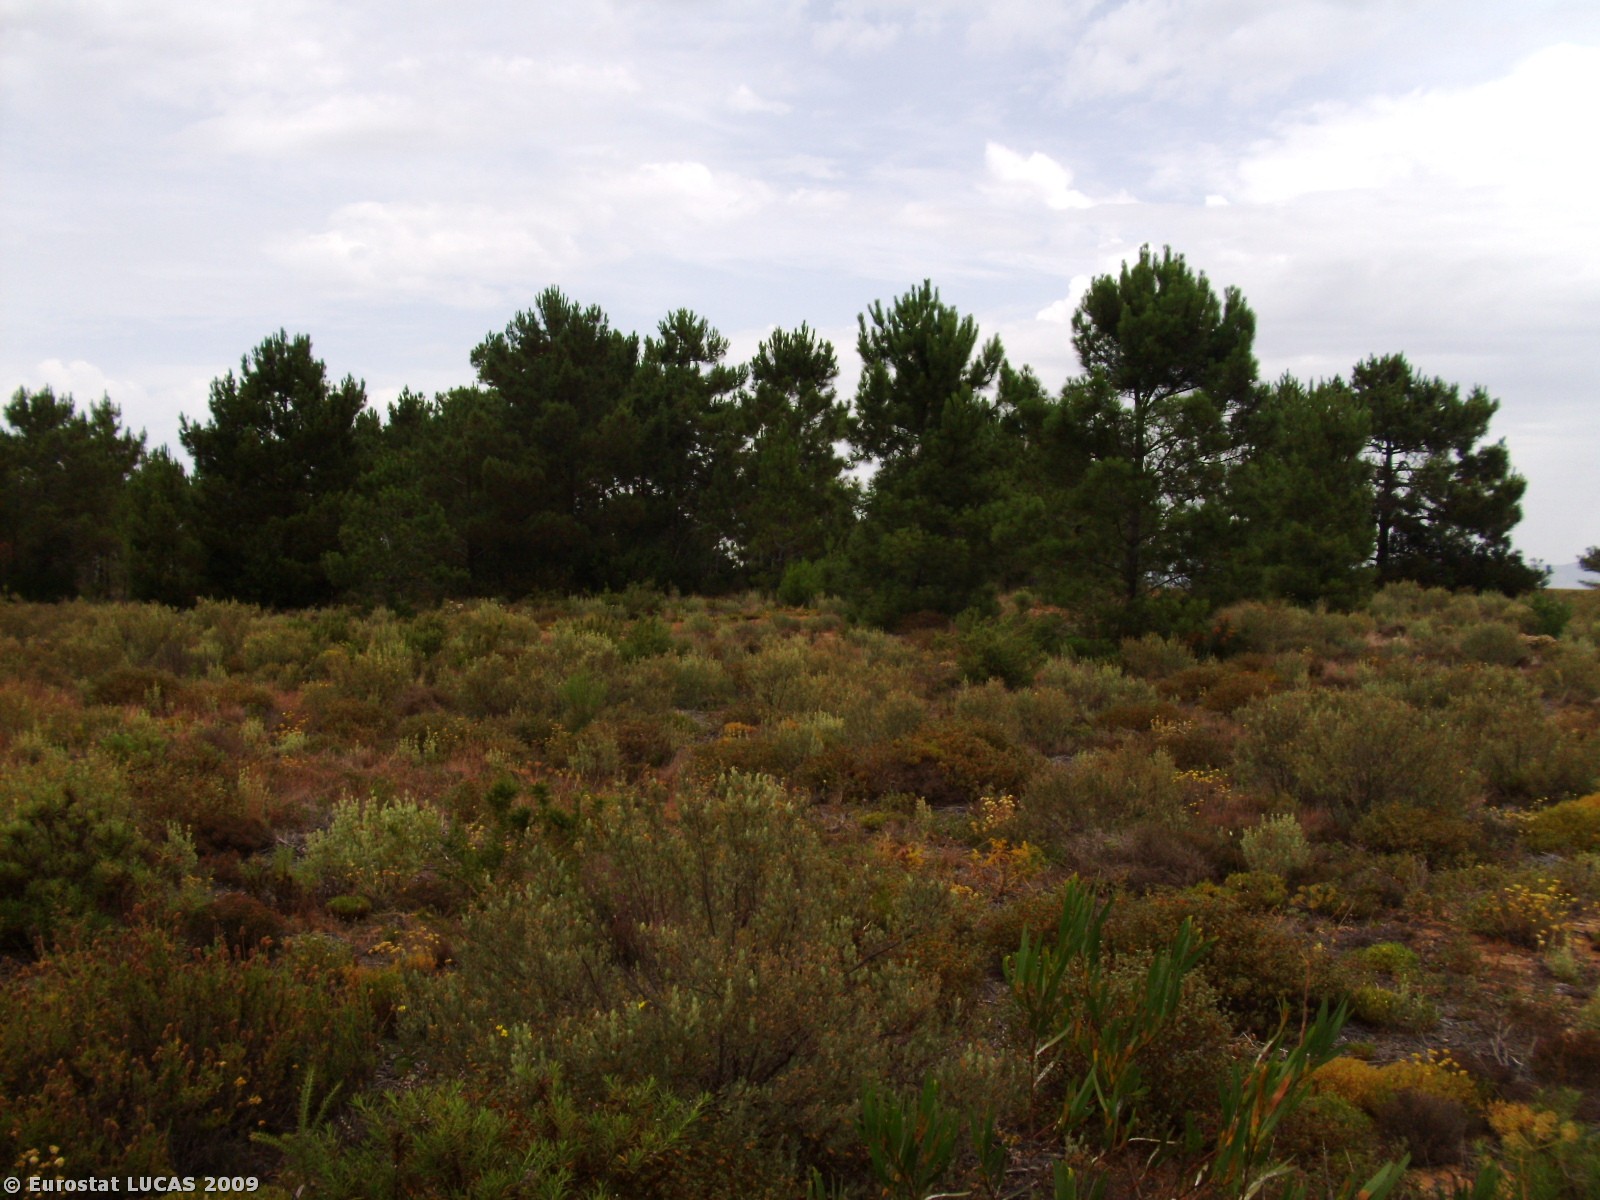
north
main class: Shrubland
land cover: Shrubland without tree cover
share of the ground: > 75 %
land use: Nature reserves
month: June
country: PT
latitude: 37.6351
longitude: -8.7974
